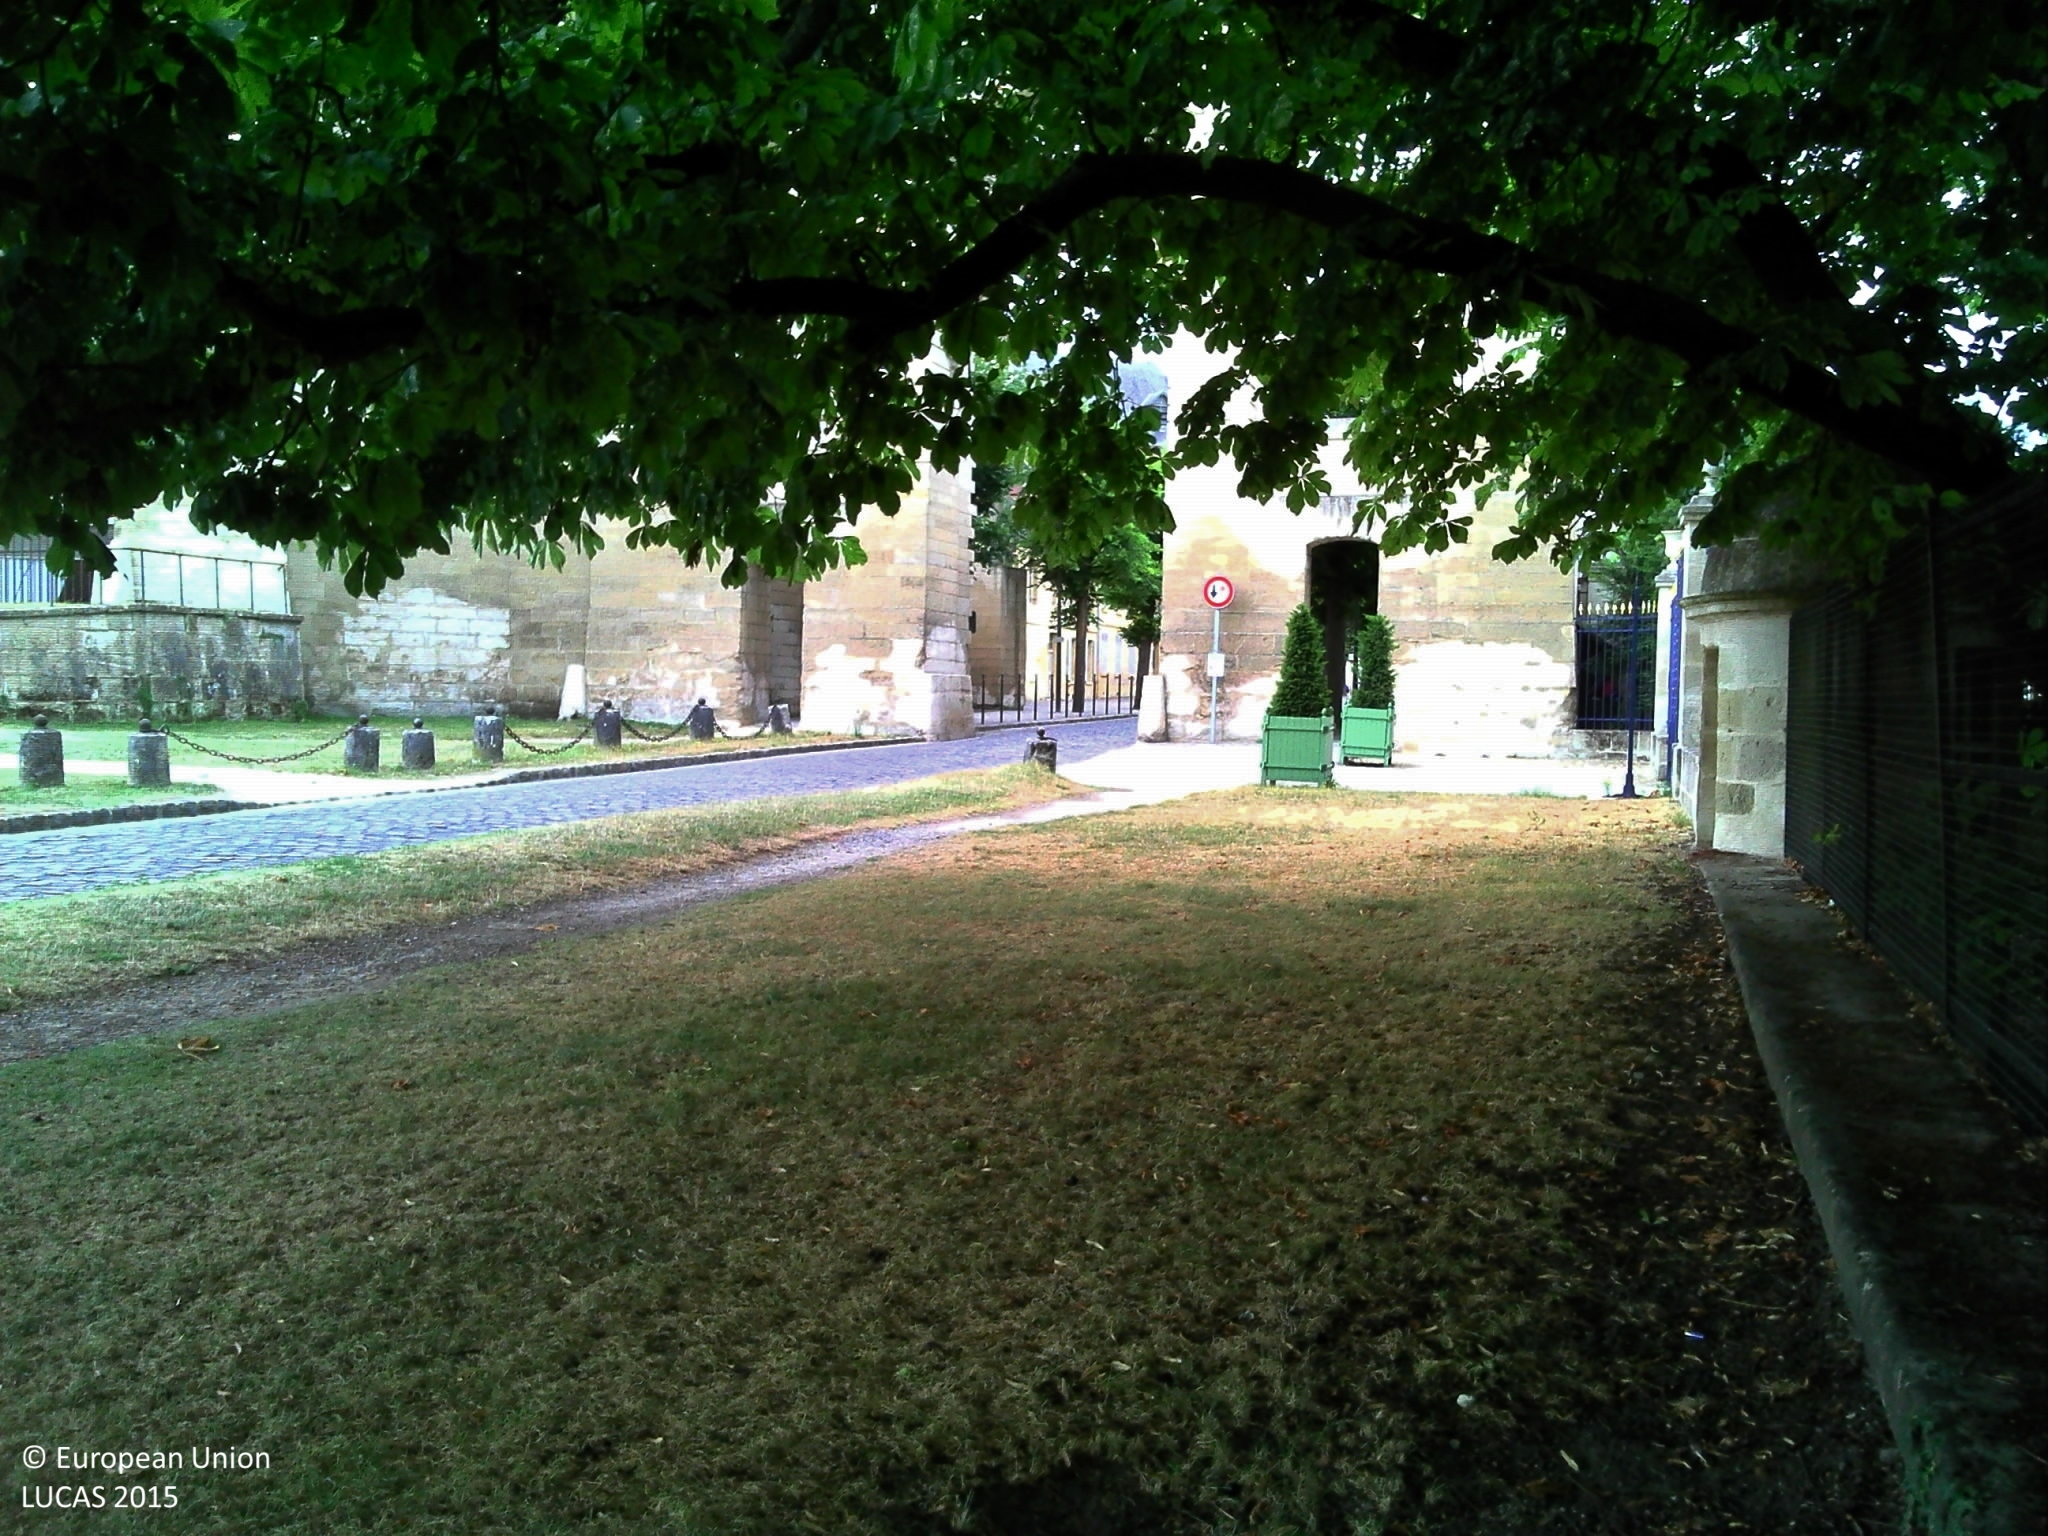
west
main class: Grassland
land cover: Grassland without tree/shrub cover
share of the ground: > 75 %
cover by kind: herbaceous plants 100 %
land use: Amenities, museums, leisure
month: July
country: FR
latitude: 49.1953
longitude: 2.4819
